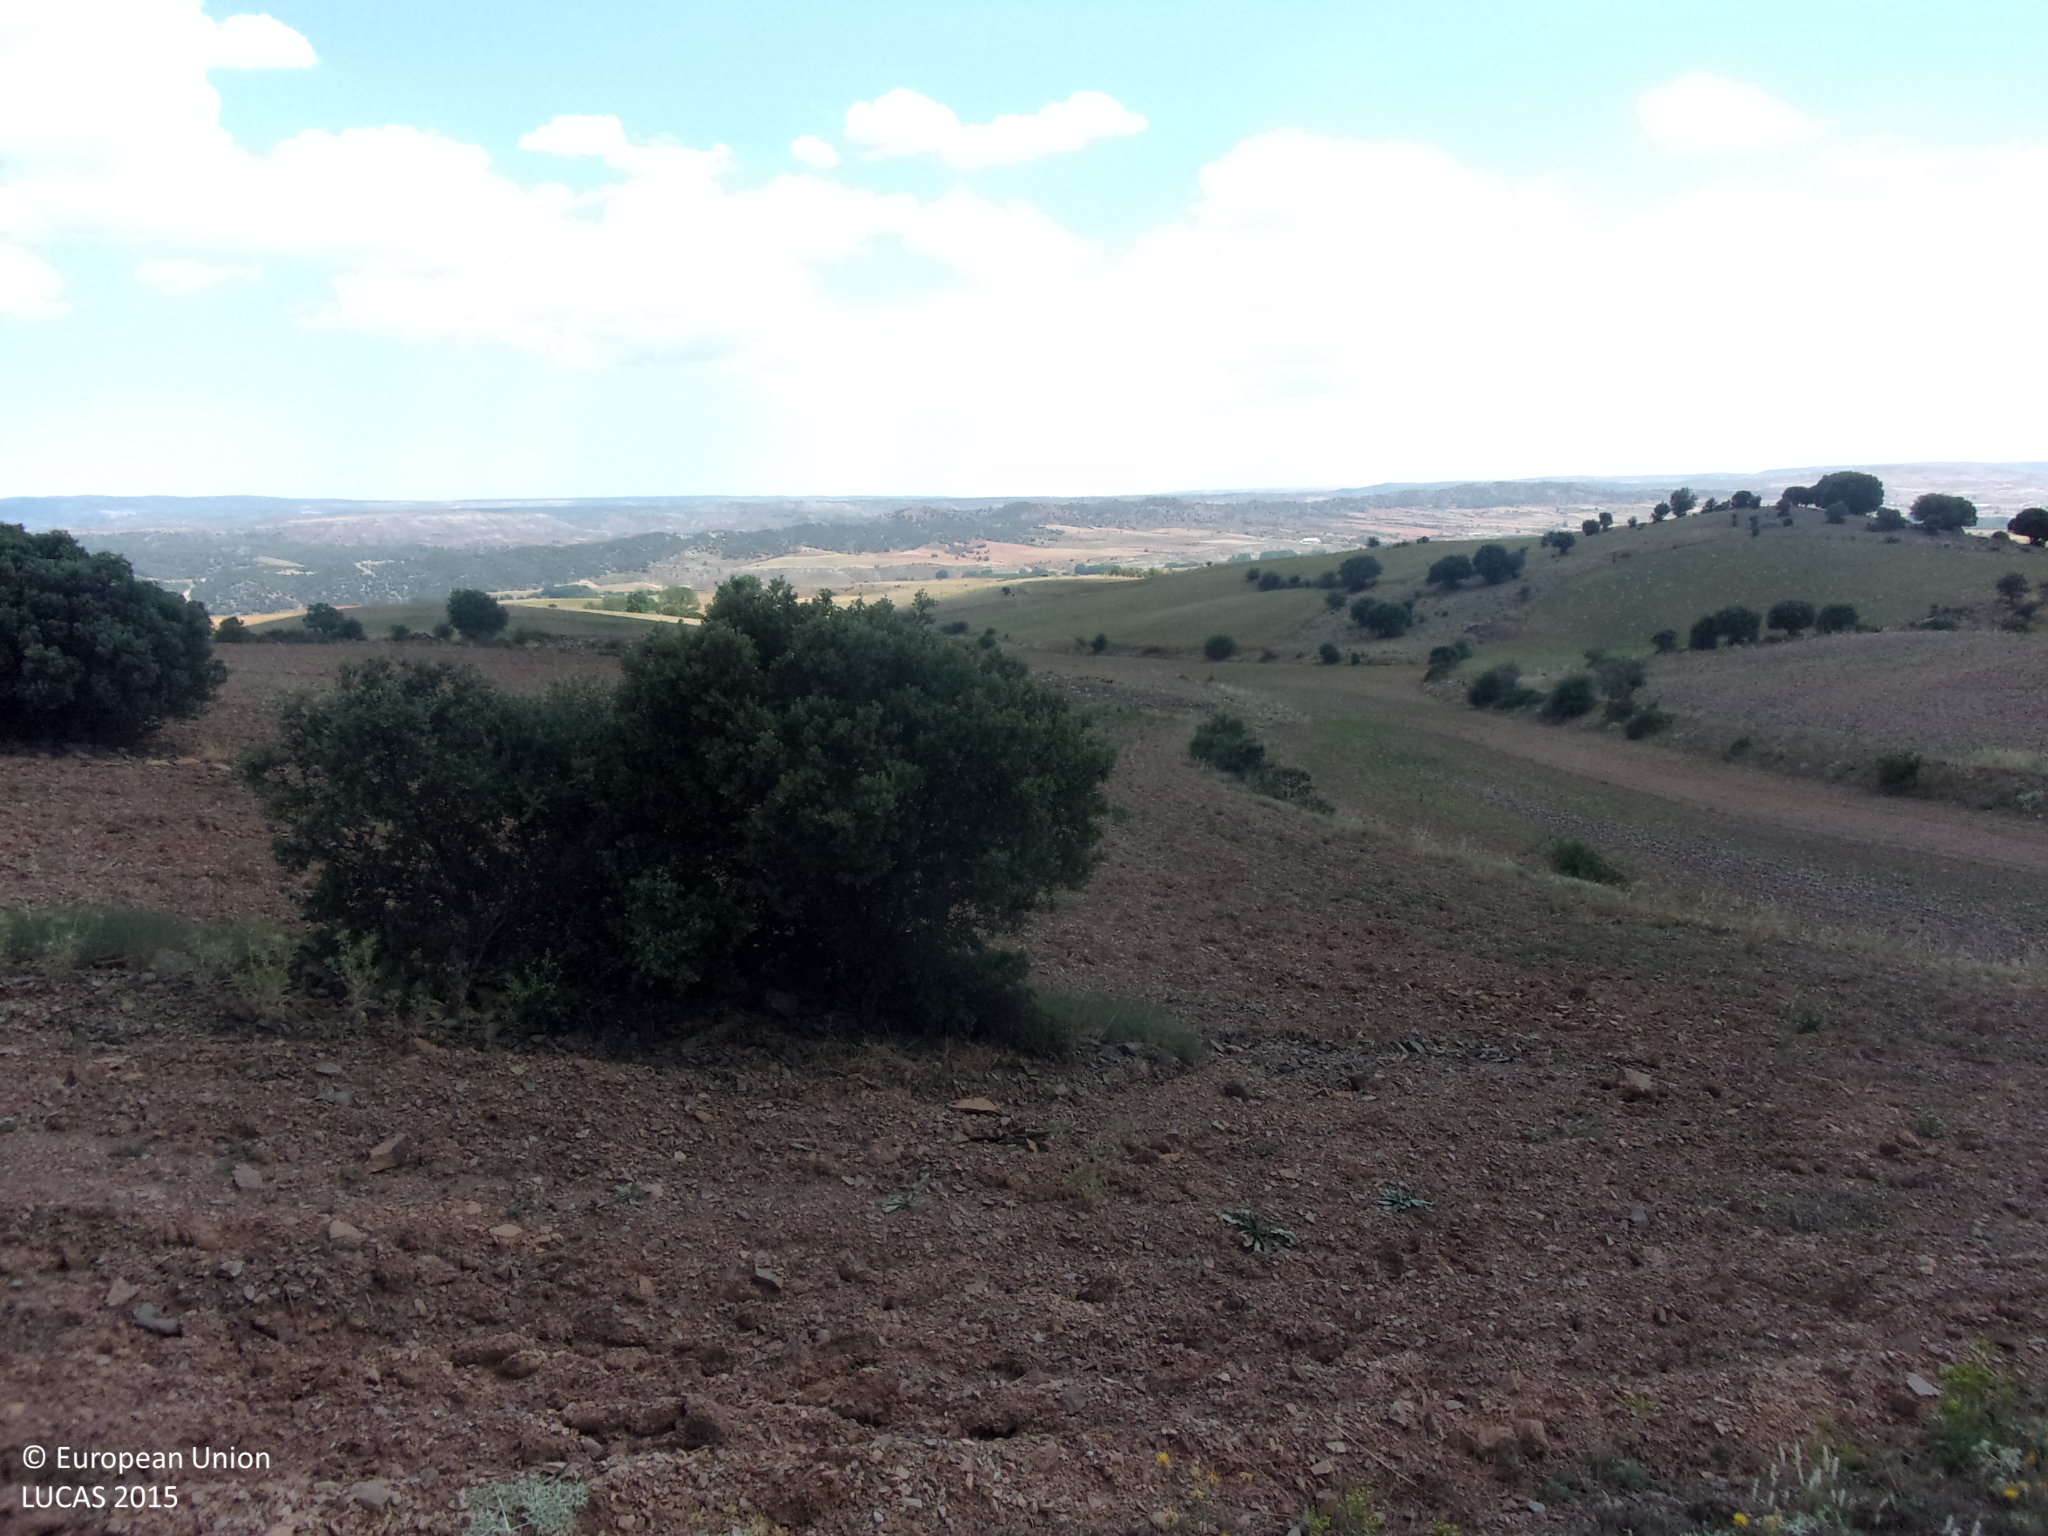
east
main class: Shrubland
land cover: Shrubland with sparse tree cover
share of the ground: > 75 %
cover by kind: shrubs 65 %, consolidated bare surface 20 %, herbaceous plants 10 %, broadleaved forest trees 5 %
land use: Semi-natural and natural areas not in use
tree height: < 5 m
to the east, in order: Shrubland with sparse tree cover; Other bare soil; Grassland without tree/shrub cover; Other bare soil; Grass margins; Spontaneously vegetated surfaces
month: July
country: ES
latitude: 40.9577
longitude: -1.3412
